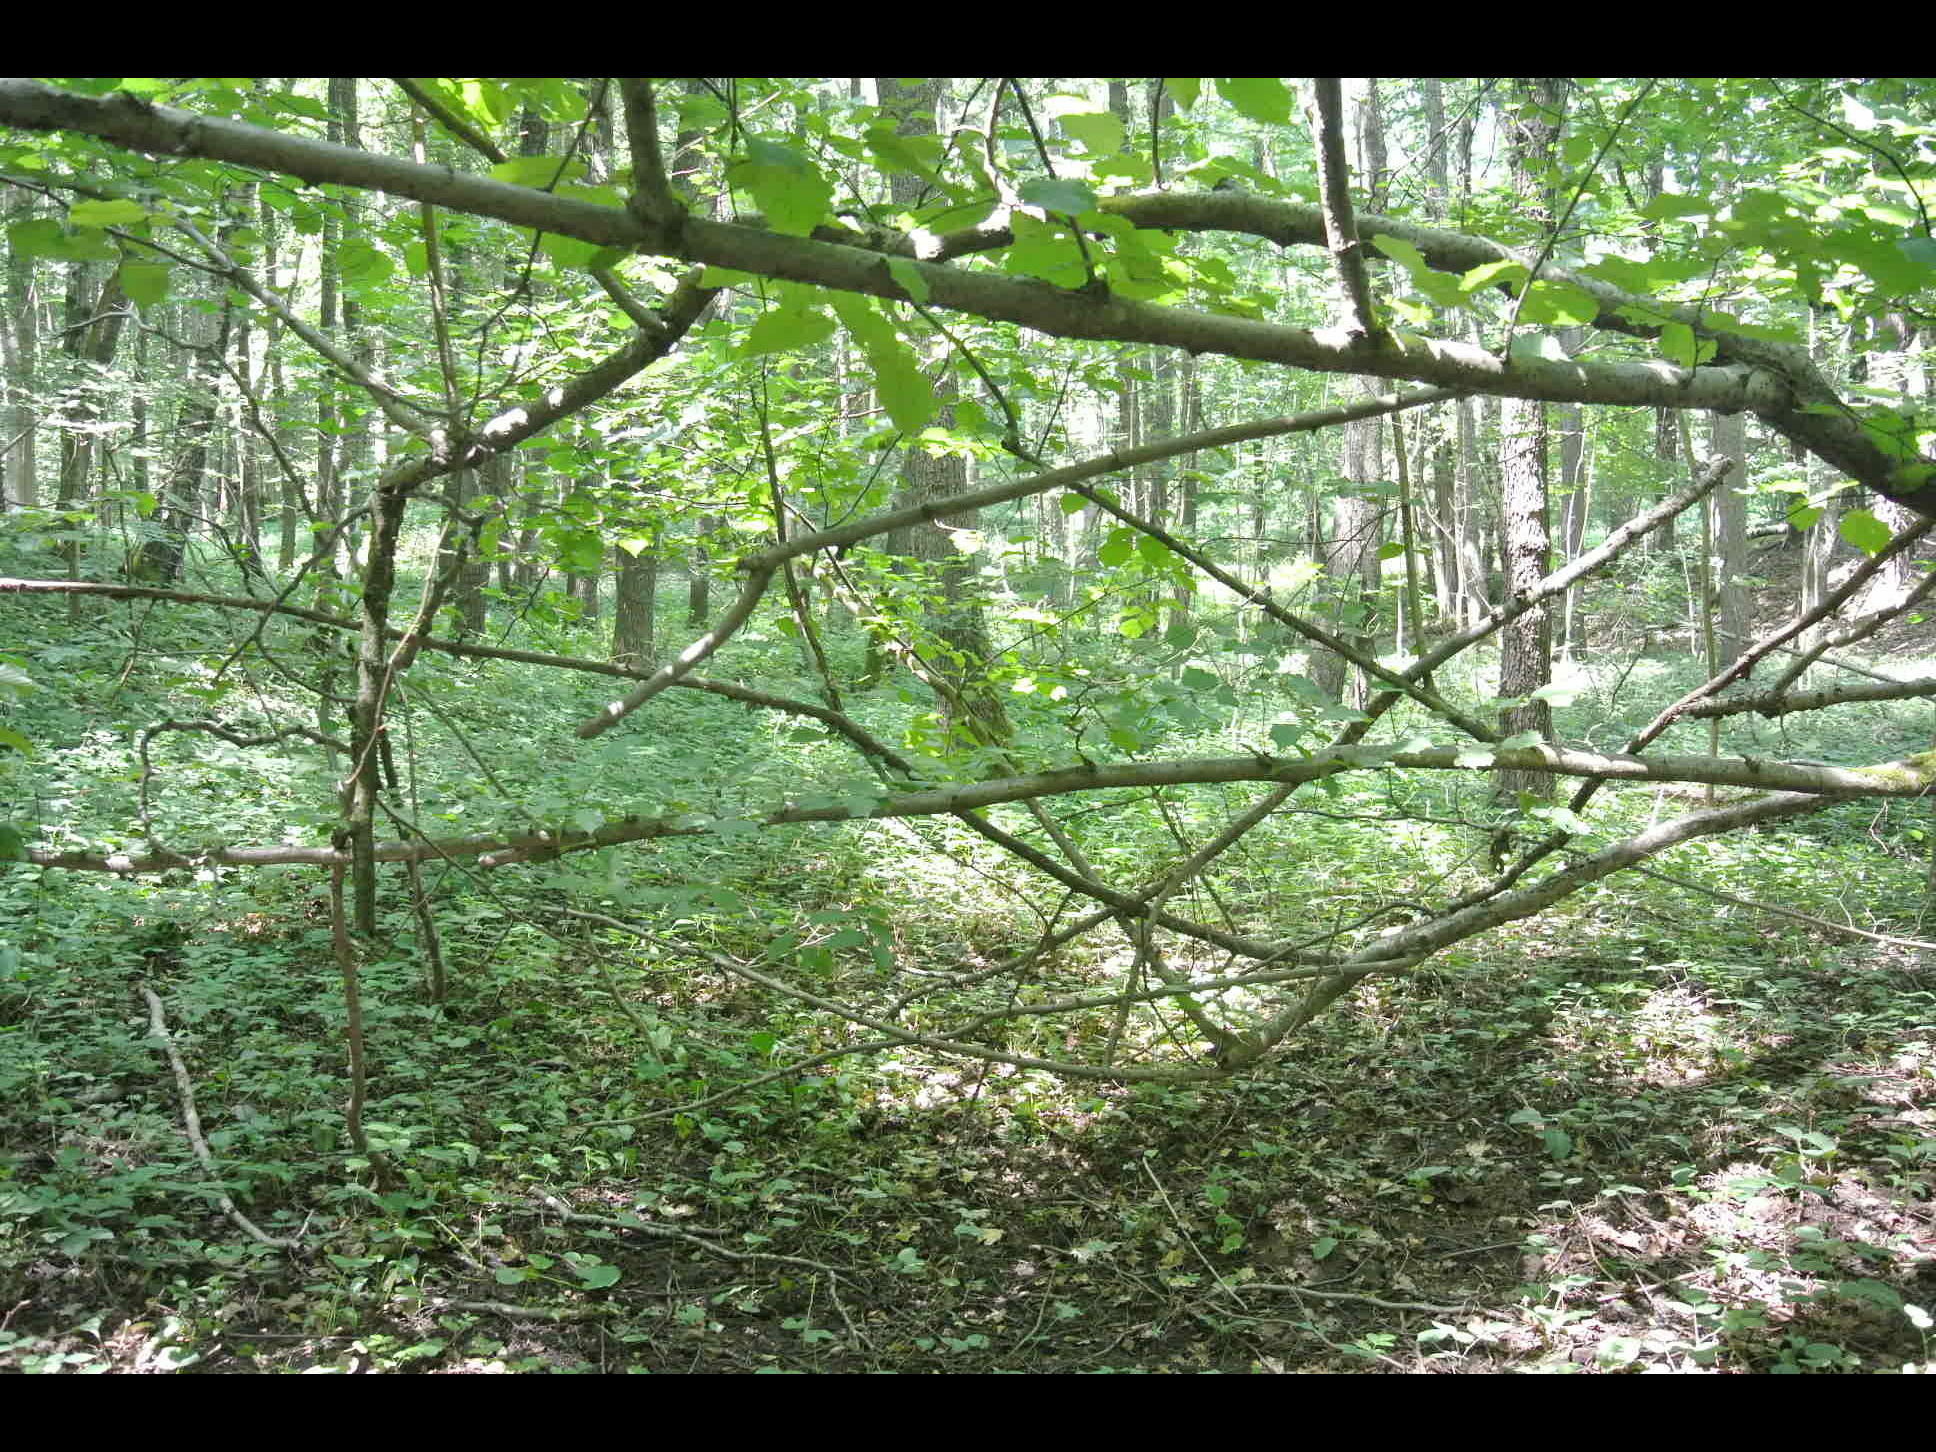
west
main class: Woodland
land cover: Broadleaved woodland
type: beech forest
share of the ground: > 75 %
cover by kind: broadleaved forest trees 90 %, herbaceous plants 10 %
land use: Forestry
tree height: > 5 m
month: July
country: AT
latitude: 48.0454
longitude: 15.5960
